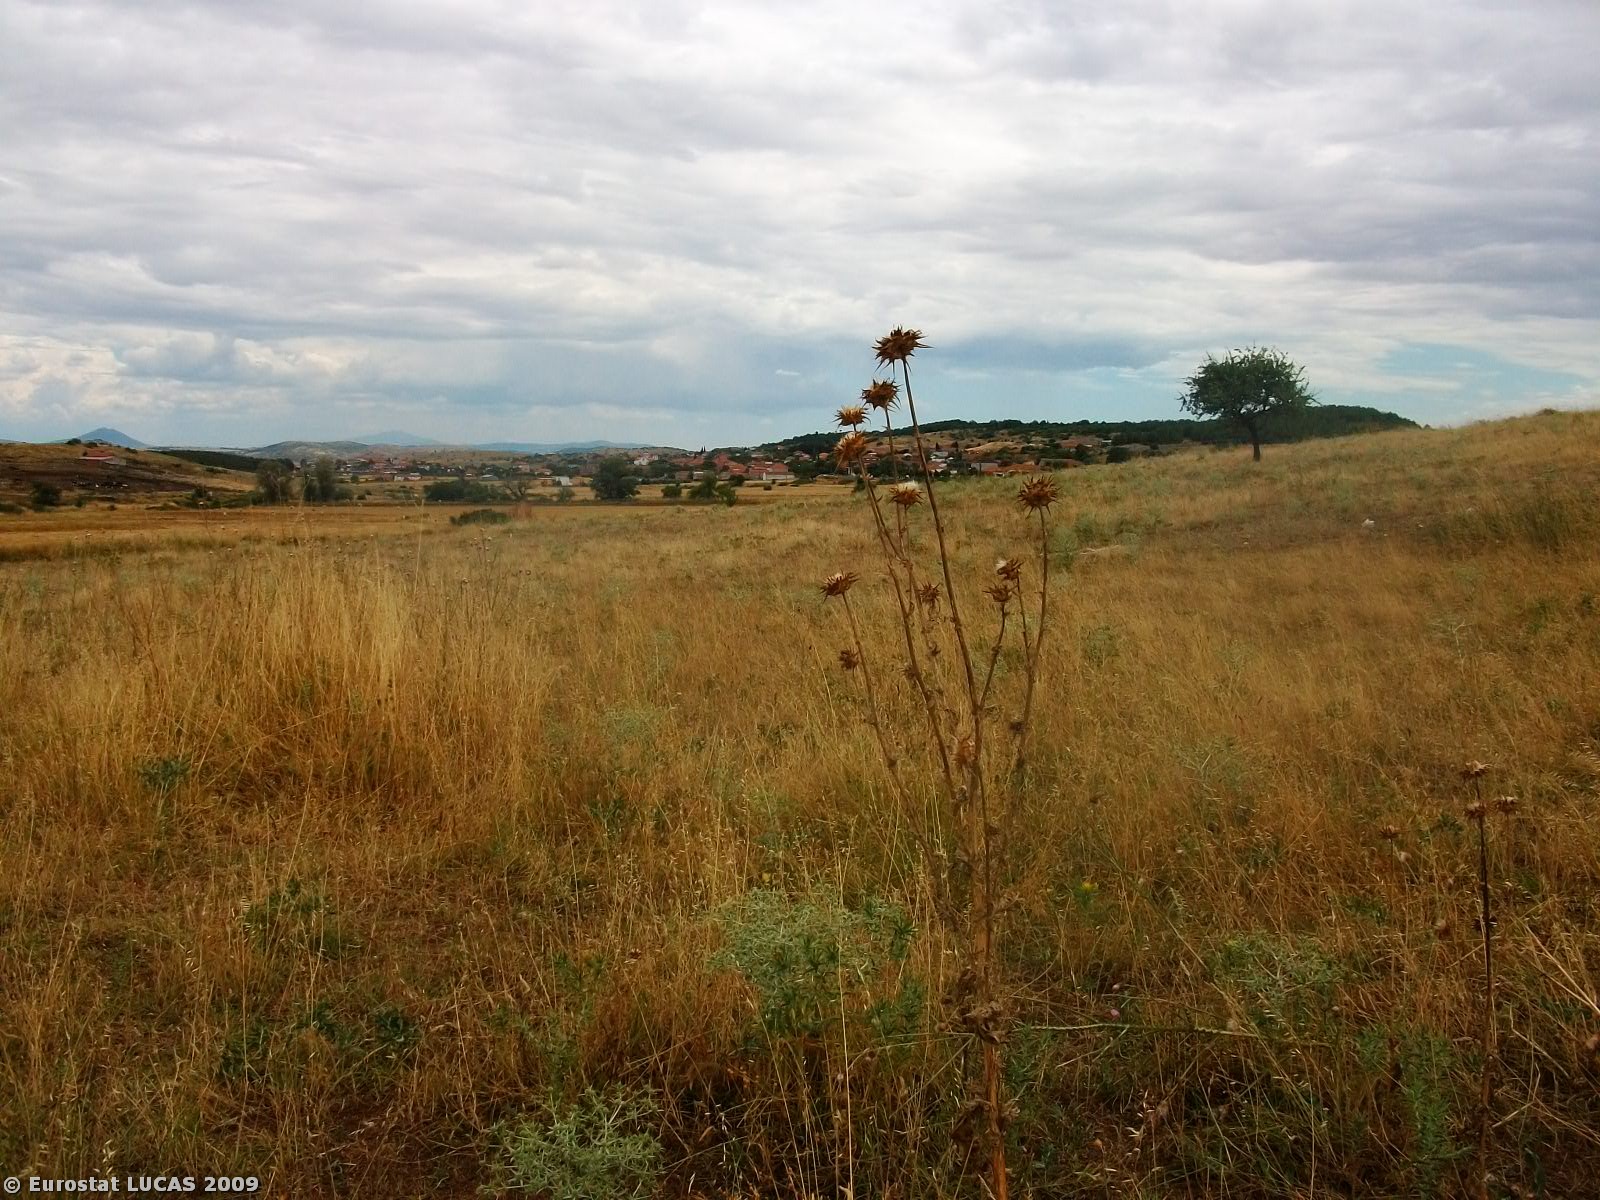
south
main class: Grassland
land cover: Grassland without tree/shrub cover
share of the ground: > 75 %
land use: Unused
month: June
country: GR
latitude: 41.0083
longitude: 22.7192
